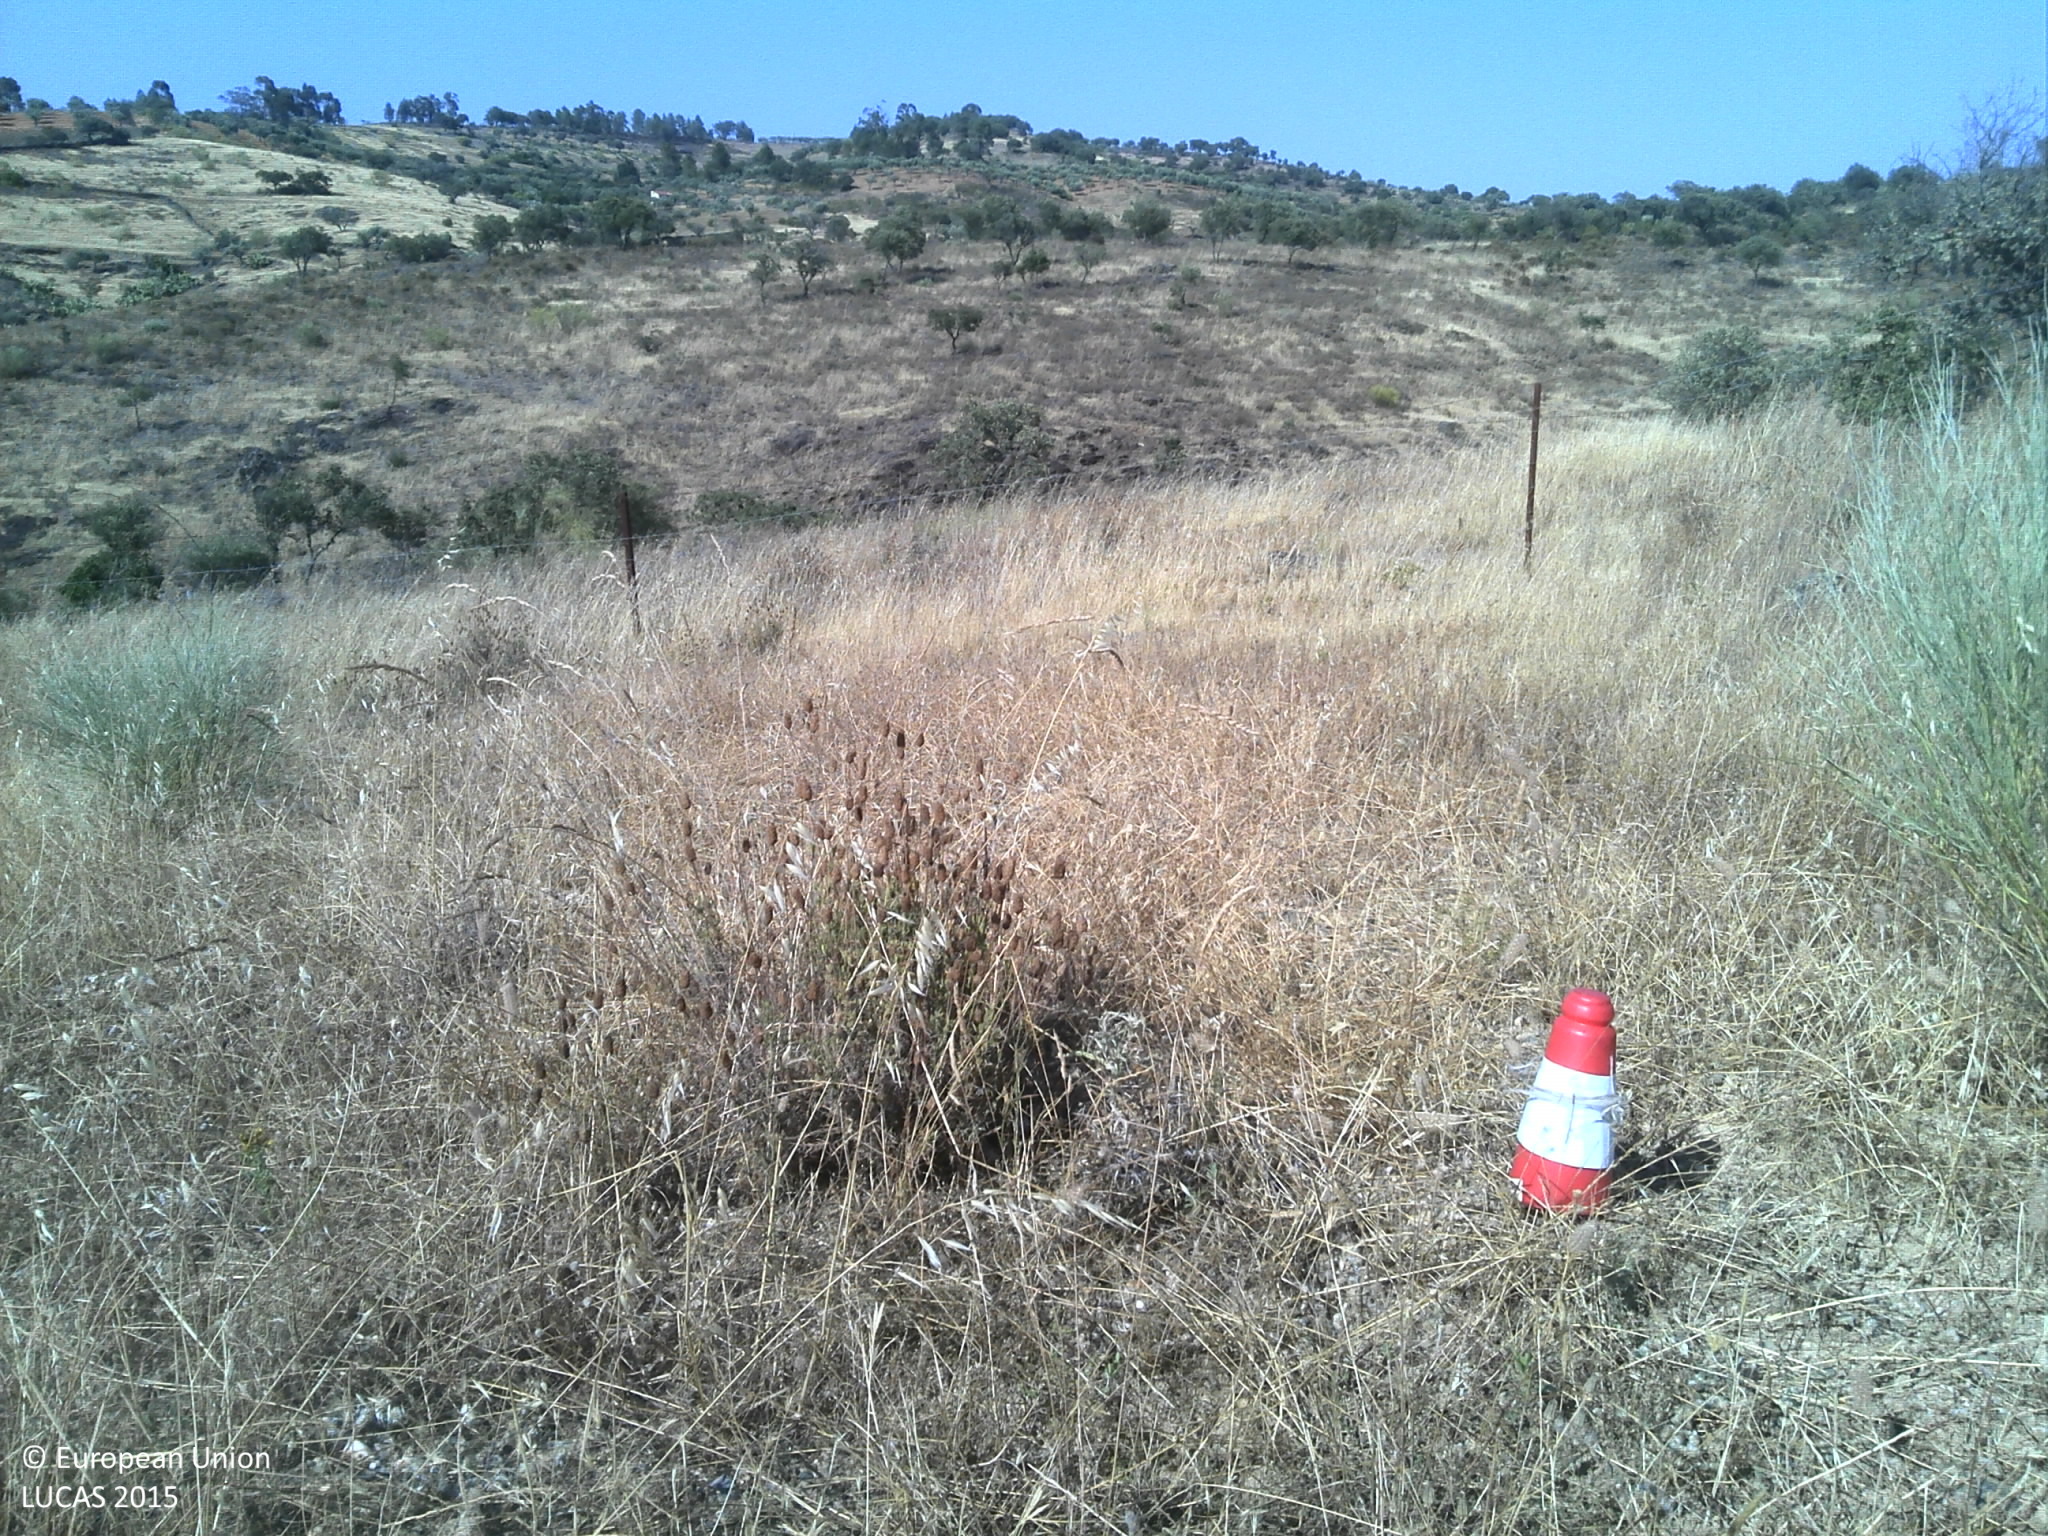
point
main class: Grassland
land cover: Grassland without tree/shrub cover
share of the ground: 50 - 75 %
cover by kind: herbaceous plants 70 %, unconsolidated bare surface 20 %, shrubs 5 %
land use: Agriculture (excluding fallow land and kitchen gardens)
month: June
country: PT
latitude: 39.6993
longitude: -7.1745
